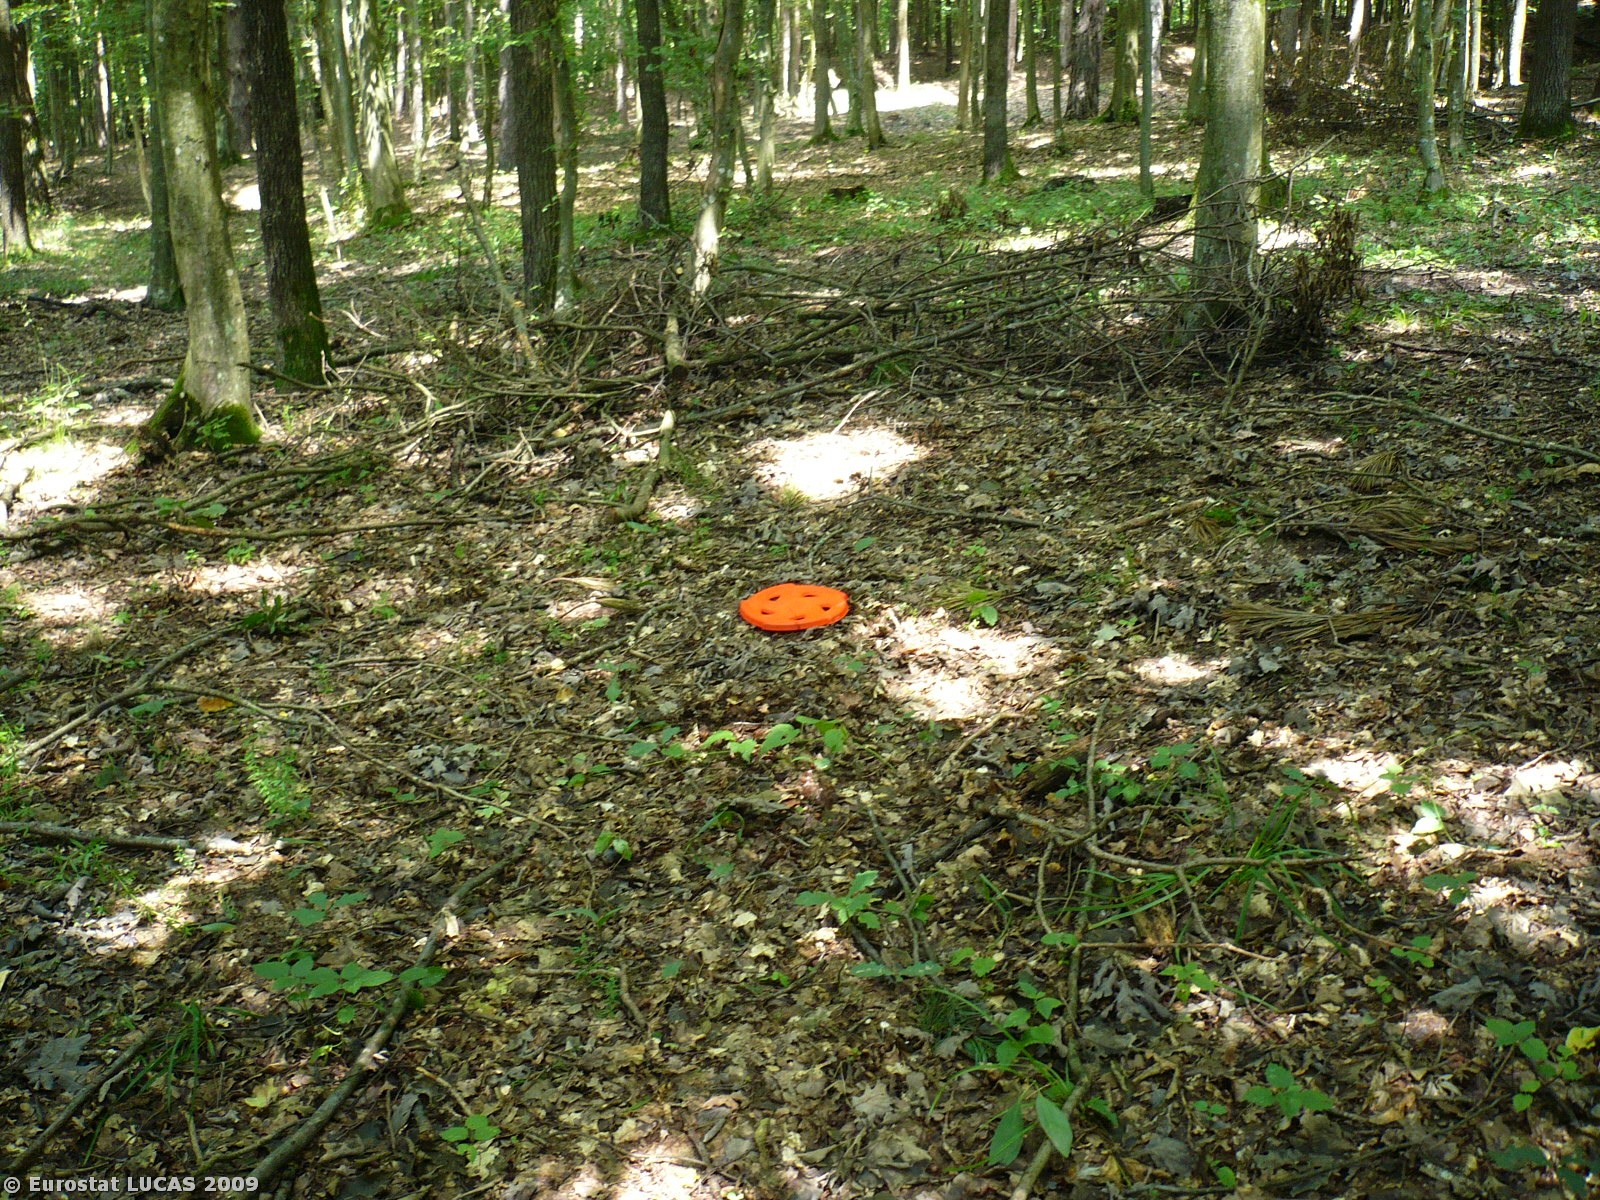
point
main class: Woodland
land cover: Broadleaved woodland
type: mesophytic deciduous forest
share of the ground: > 75 %
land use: Forestry
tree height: > 5 m
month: July
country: SI
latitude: 46.6688
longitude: 16.3404
